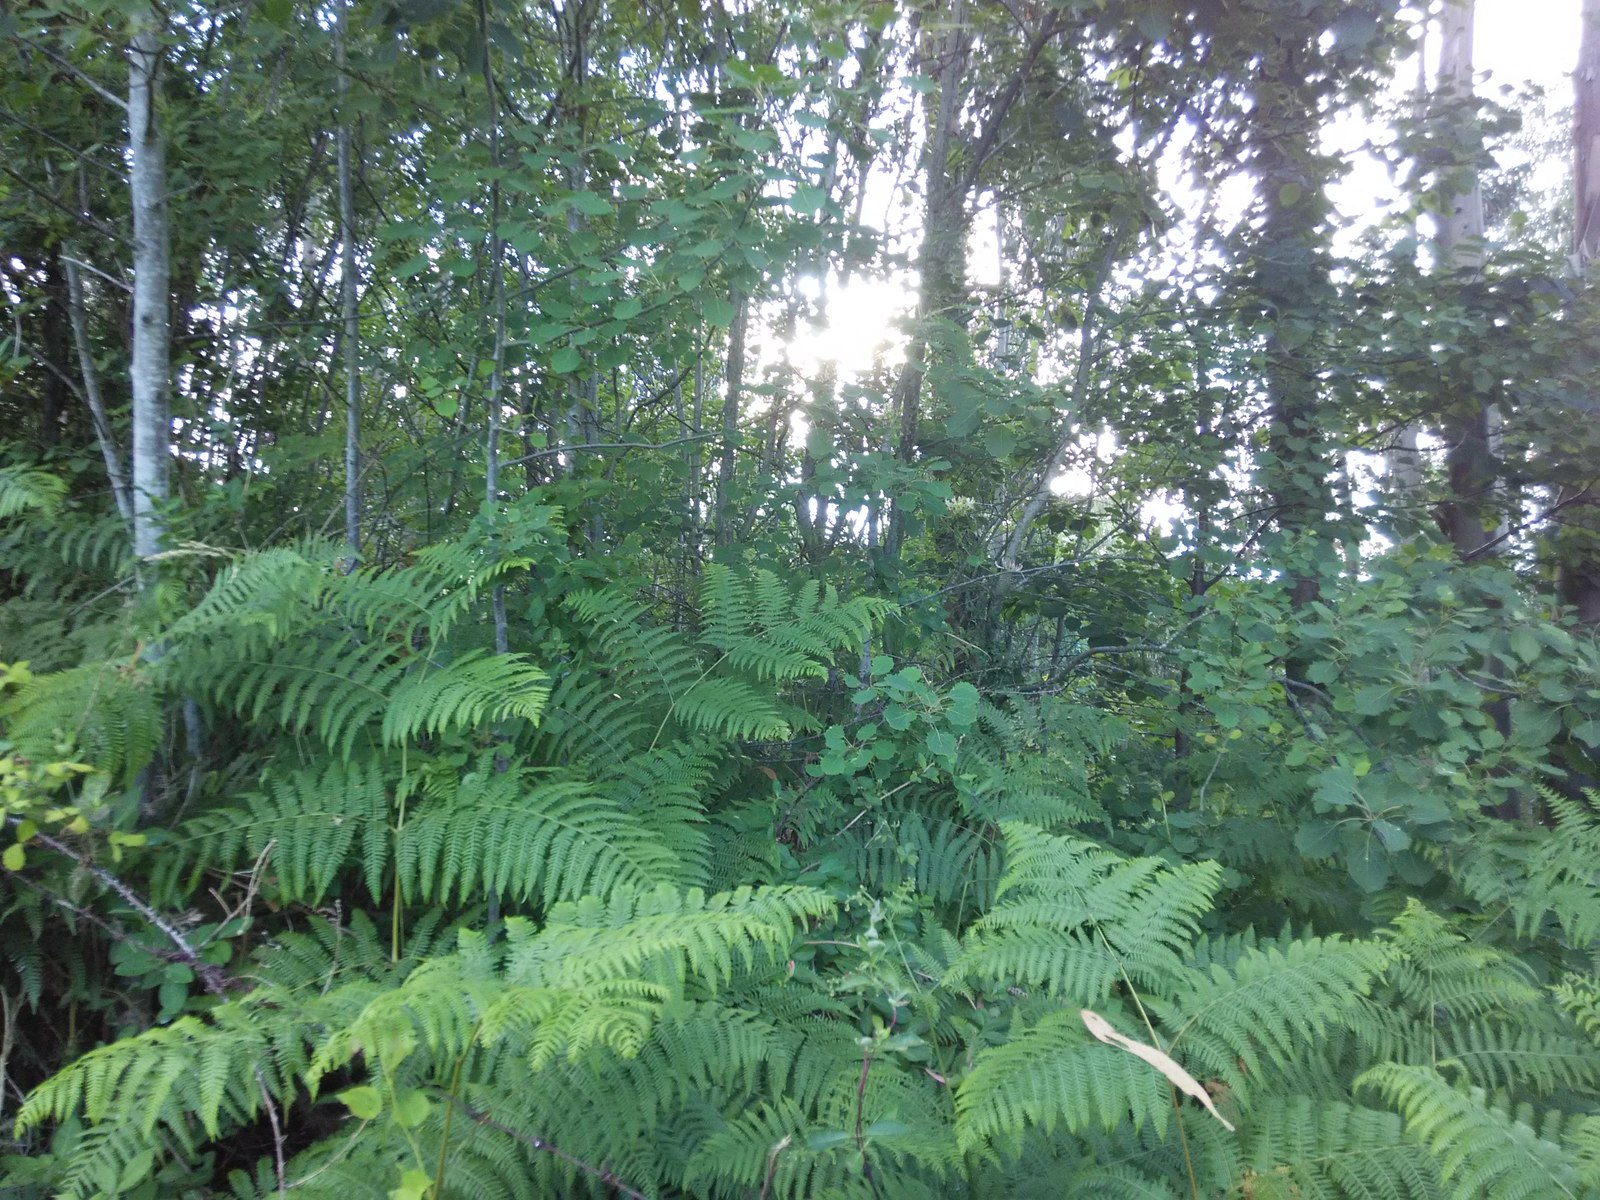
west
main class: Woodland
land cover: Broadleaved woodland
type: exotic forest
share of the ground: > 75 %
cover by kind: broadleaved forest trees 90 %, shrubs 10 %
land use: Forestry
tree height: > 5 m
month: June
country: ES
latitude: 43.3392
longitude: -2.4745
